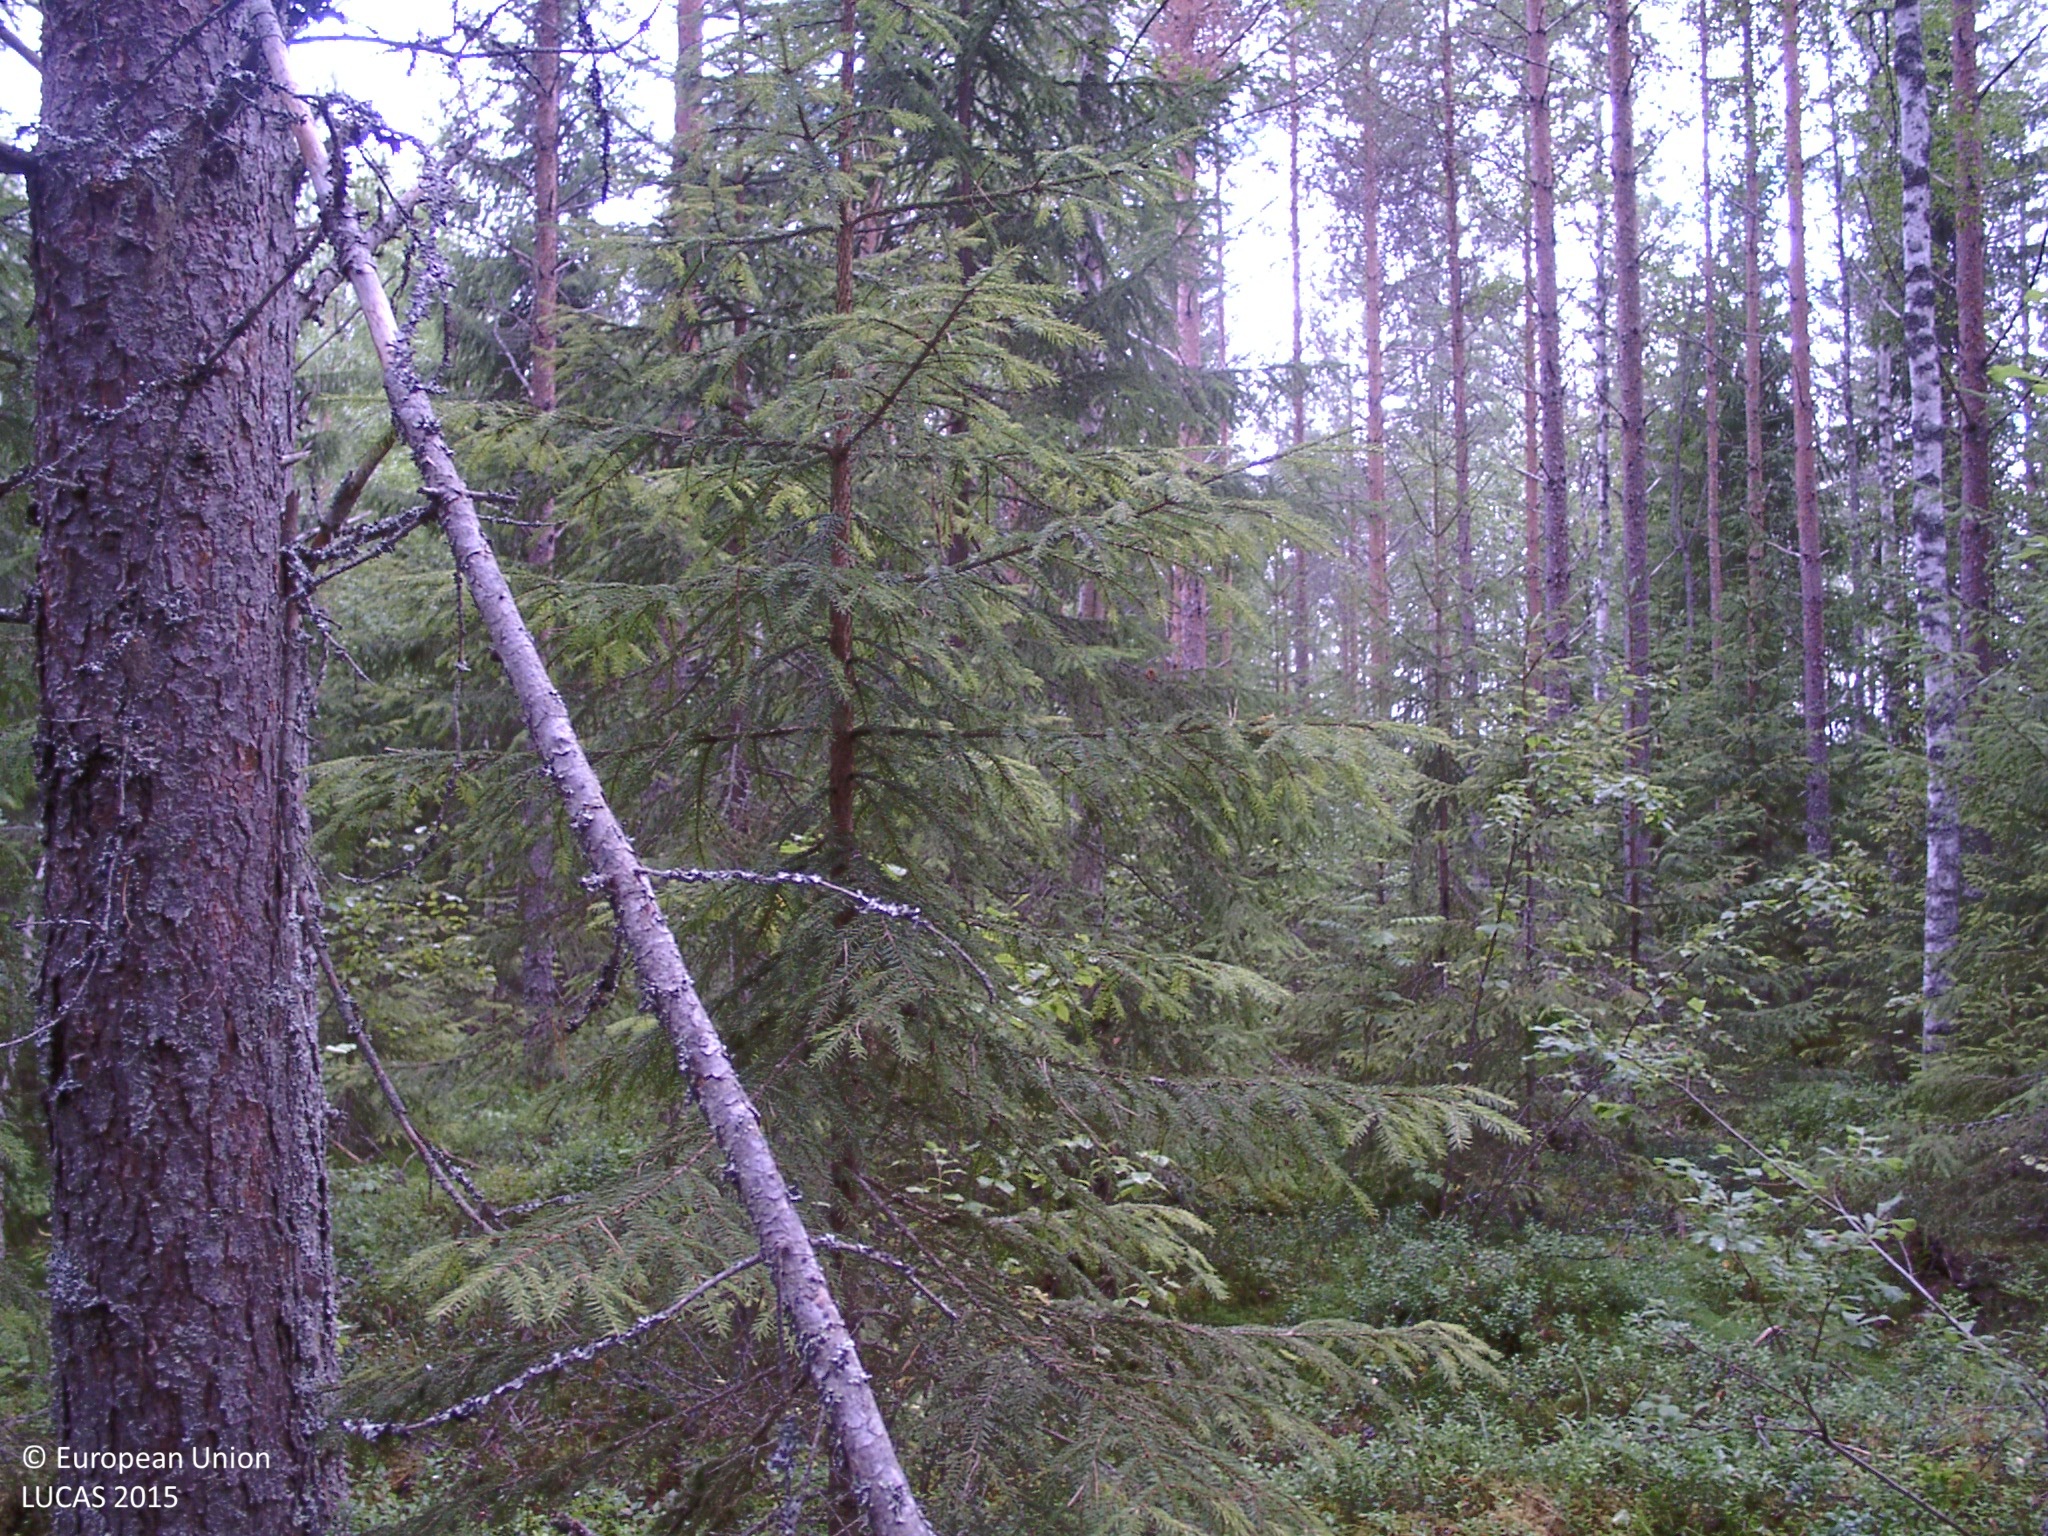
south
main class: Woodland
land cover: Other mixed woodland
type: boreal forest
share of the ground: > 75 %
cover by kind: coniferous forest trees 45 %, broadleaved forest trees 30 %, shrubs 20 %, lichens and mosses 5 %
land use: Forestry
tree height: > 5 m
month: August
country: FI
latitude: 63.0069
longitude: 25.0861
